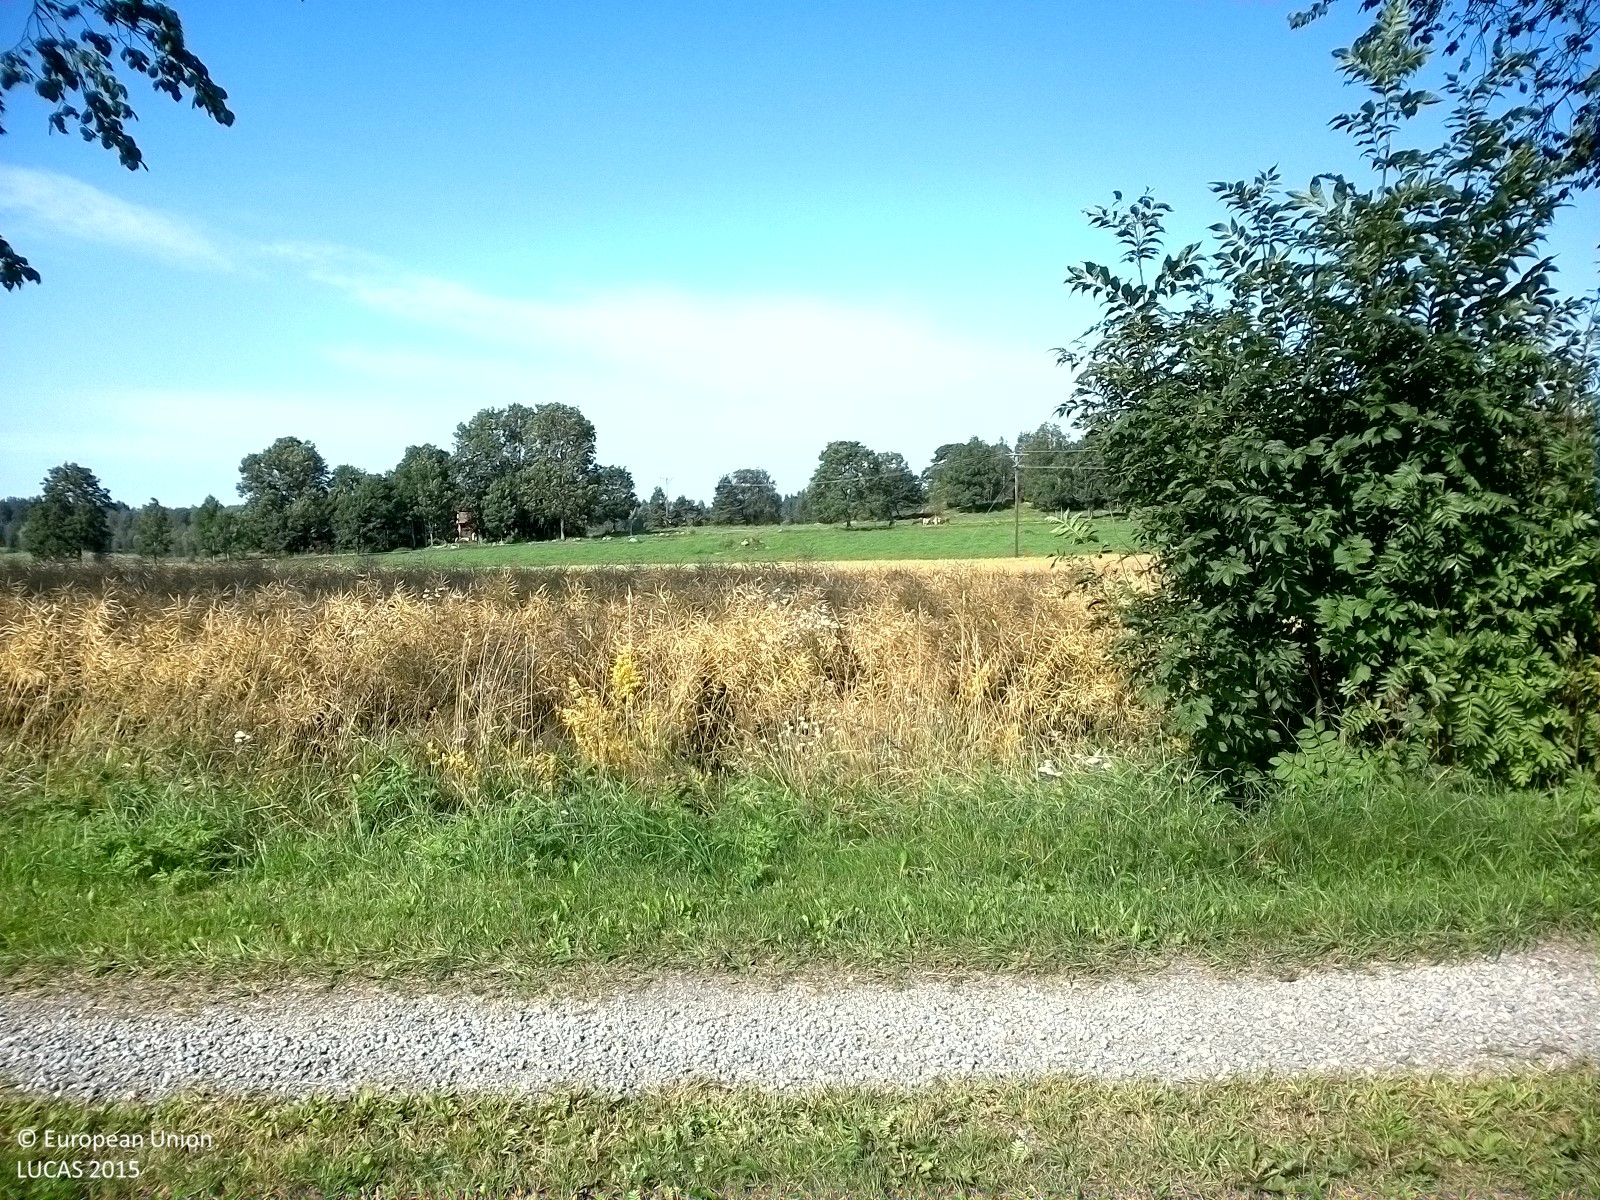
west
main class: Cropland
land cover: Rape and turnip rape
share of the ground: > 75 %
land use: Agriculture (excluding fallow land and kitchen gardens)
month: August
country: SE
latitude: 59.0497
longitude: 15.3791
